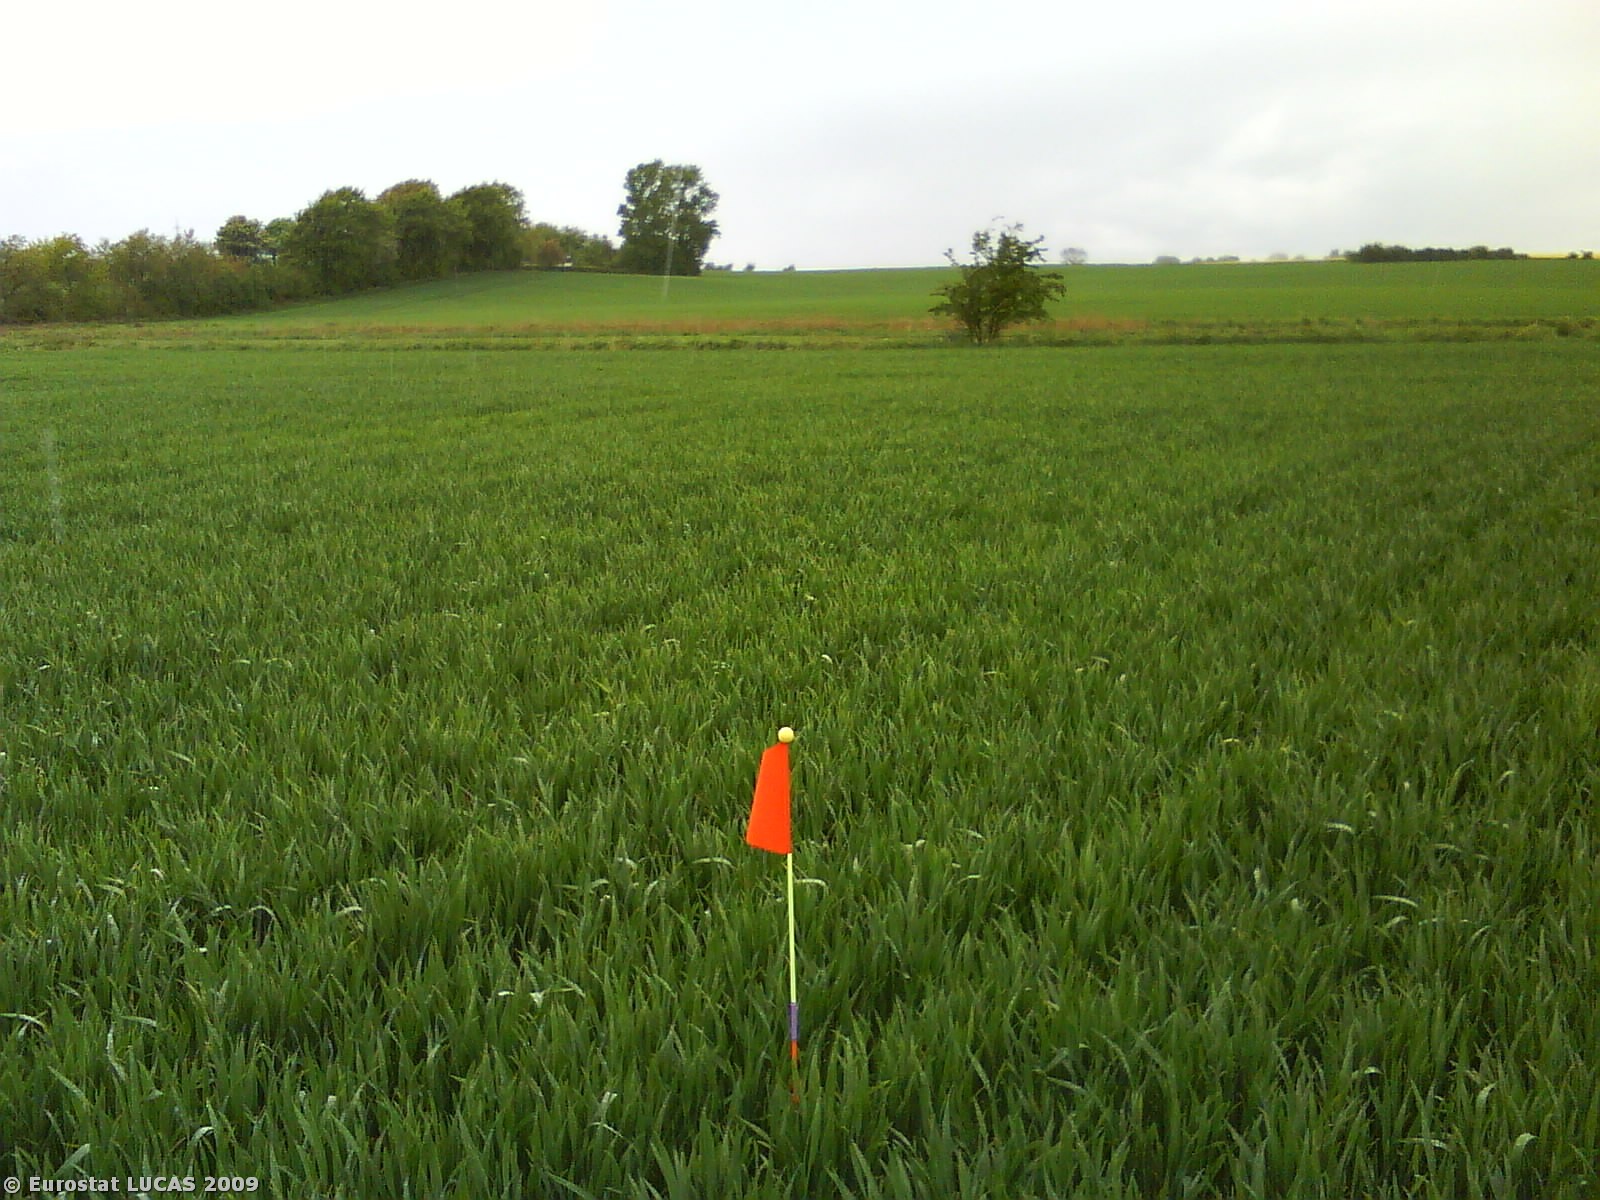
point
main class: Cropland
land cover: Common wheat
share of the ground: > 75 %
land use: Agriculture (excluding fallow land and kitchen gardens)
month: May
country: DK
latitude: 56.3674
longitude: 10.1455
